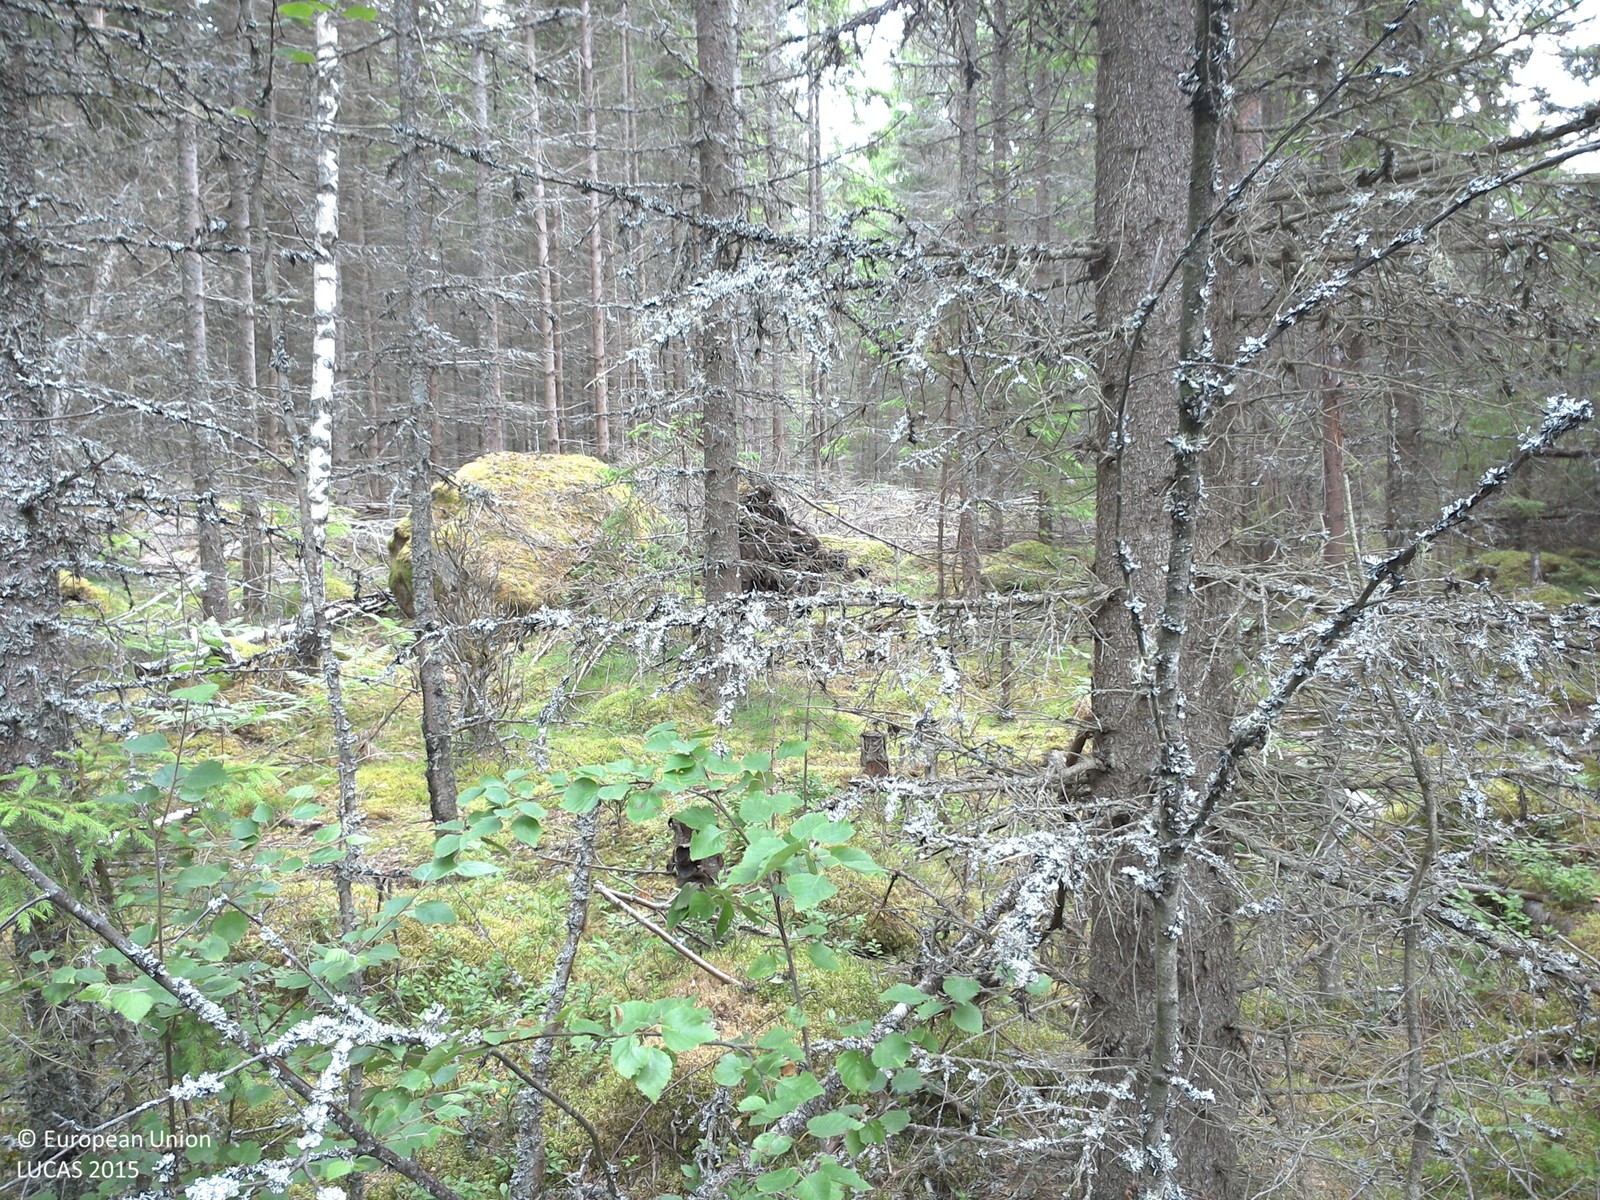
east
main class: Woodland
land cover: Spruce dominated mixed woodland
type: boreal forest
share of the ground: > 75 %
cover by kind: coniferous forest trees 55 %, broadleaved forest trees 20 %, lichens and mosses 20 %, herbaceous plants 5 %
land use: Forestry
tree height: > 5 m
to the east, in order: Spruce dominated mixed woodland; Spruce dominated coniferous woodland; Broadleaved woodland; Lichens and moss; Broadleaved woodland; Rivers and streams; Broadleaved woodland
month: July
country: SE
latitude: 58.2259
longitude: 14.7447
